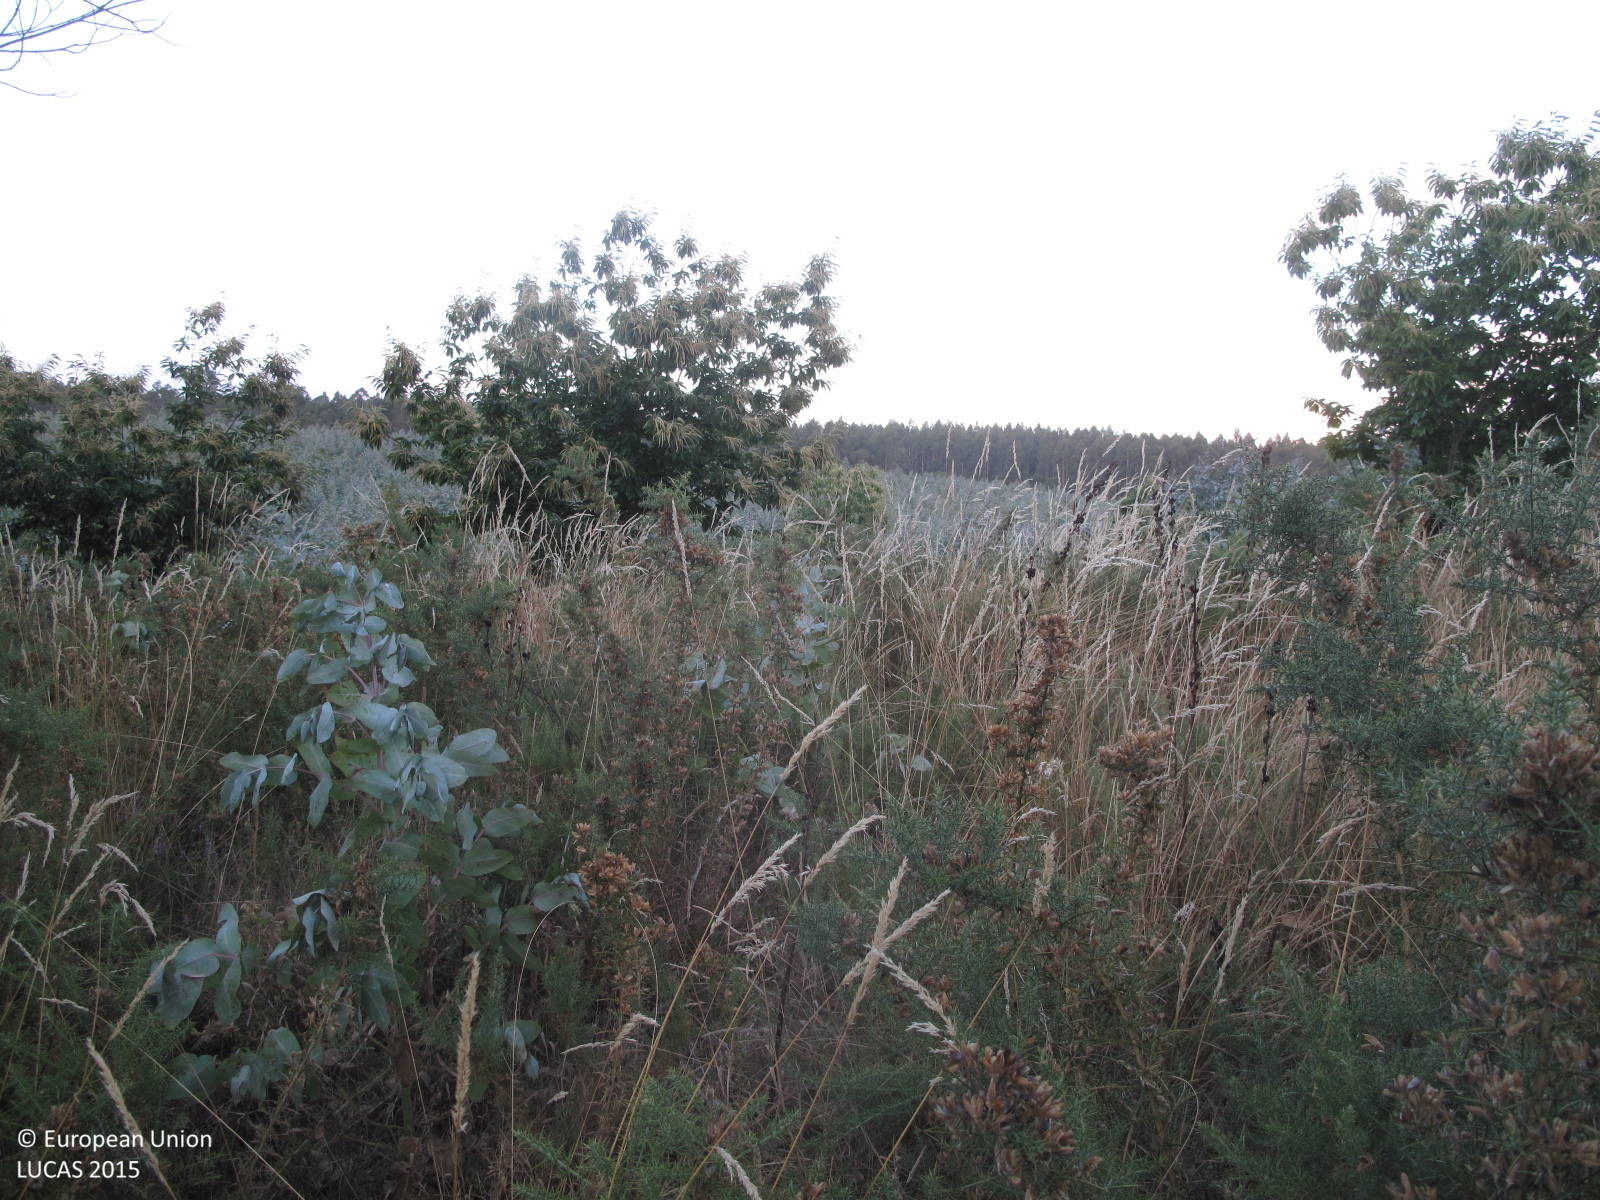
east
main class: Woodland
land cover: Broadleaved woodland
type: exotic forest
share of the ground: 10 - 25 %
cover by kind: shrubs 60 %, broadleaved forest trees 20 %, herbaceous plants 20 %
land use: Forestry
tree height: < 5 m
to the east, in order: Broadleaved woodland; Tracks; Broadleaved woodland
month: July
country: ES
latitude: 43.5524
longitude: -8.1103
